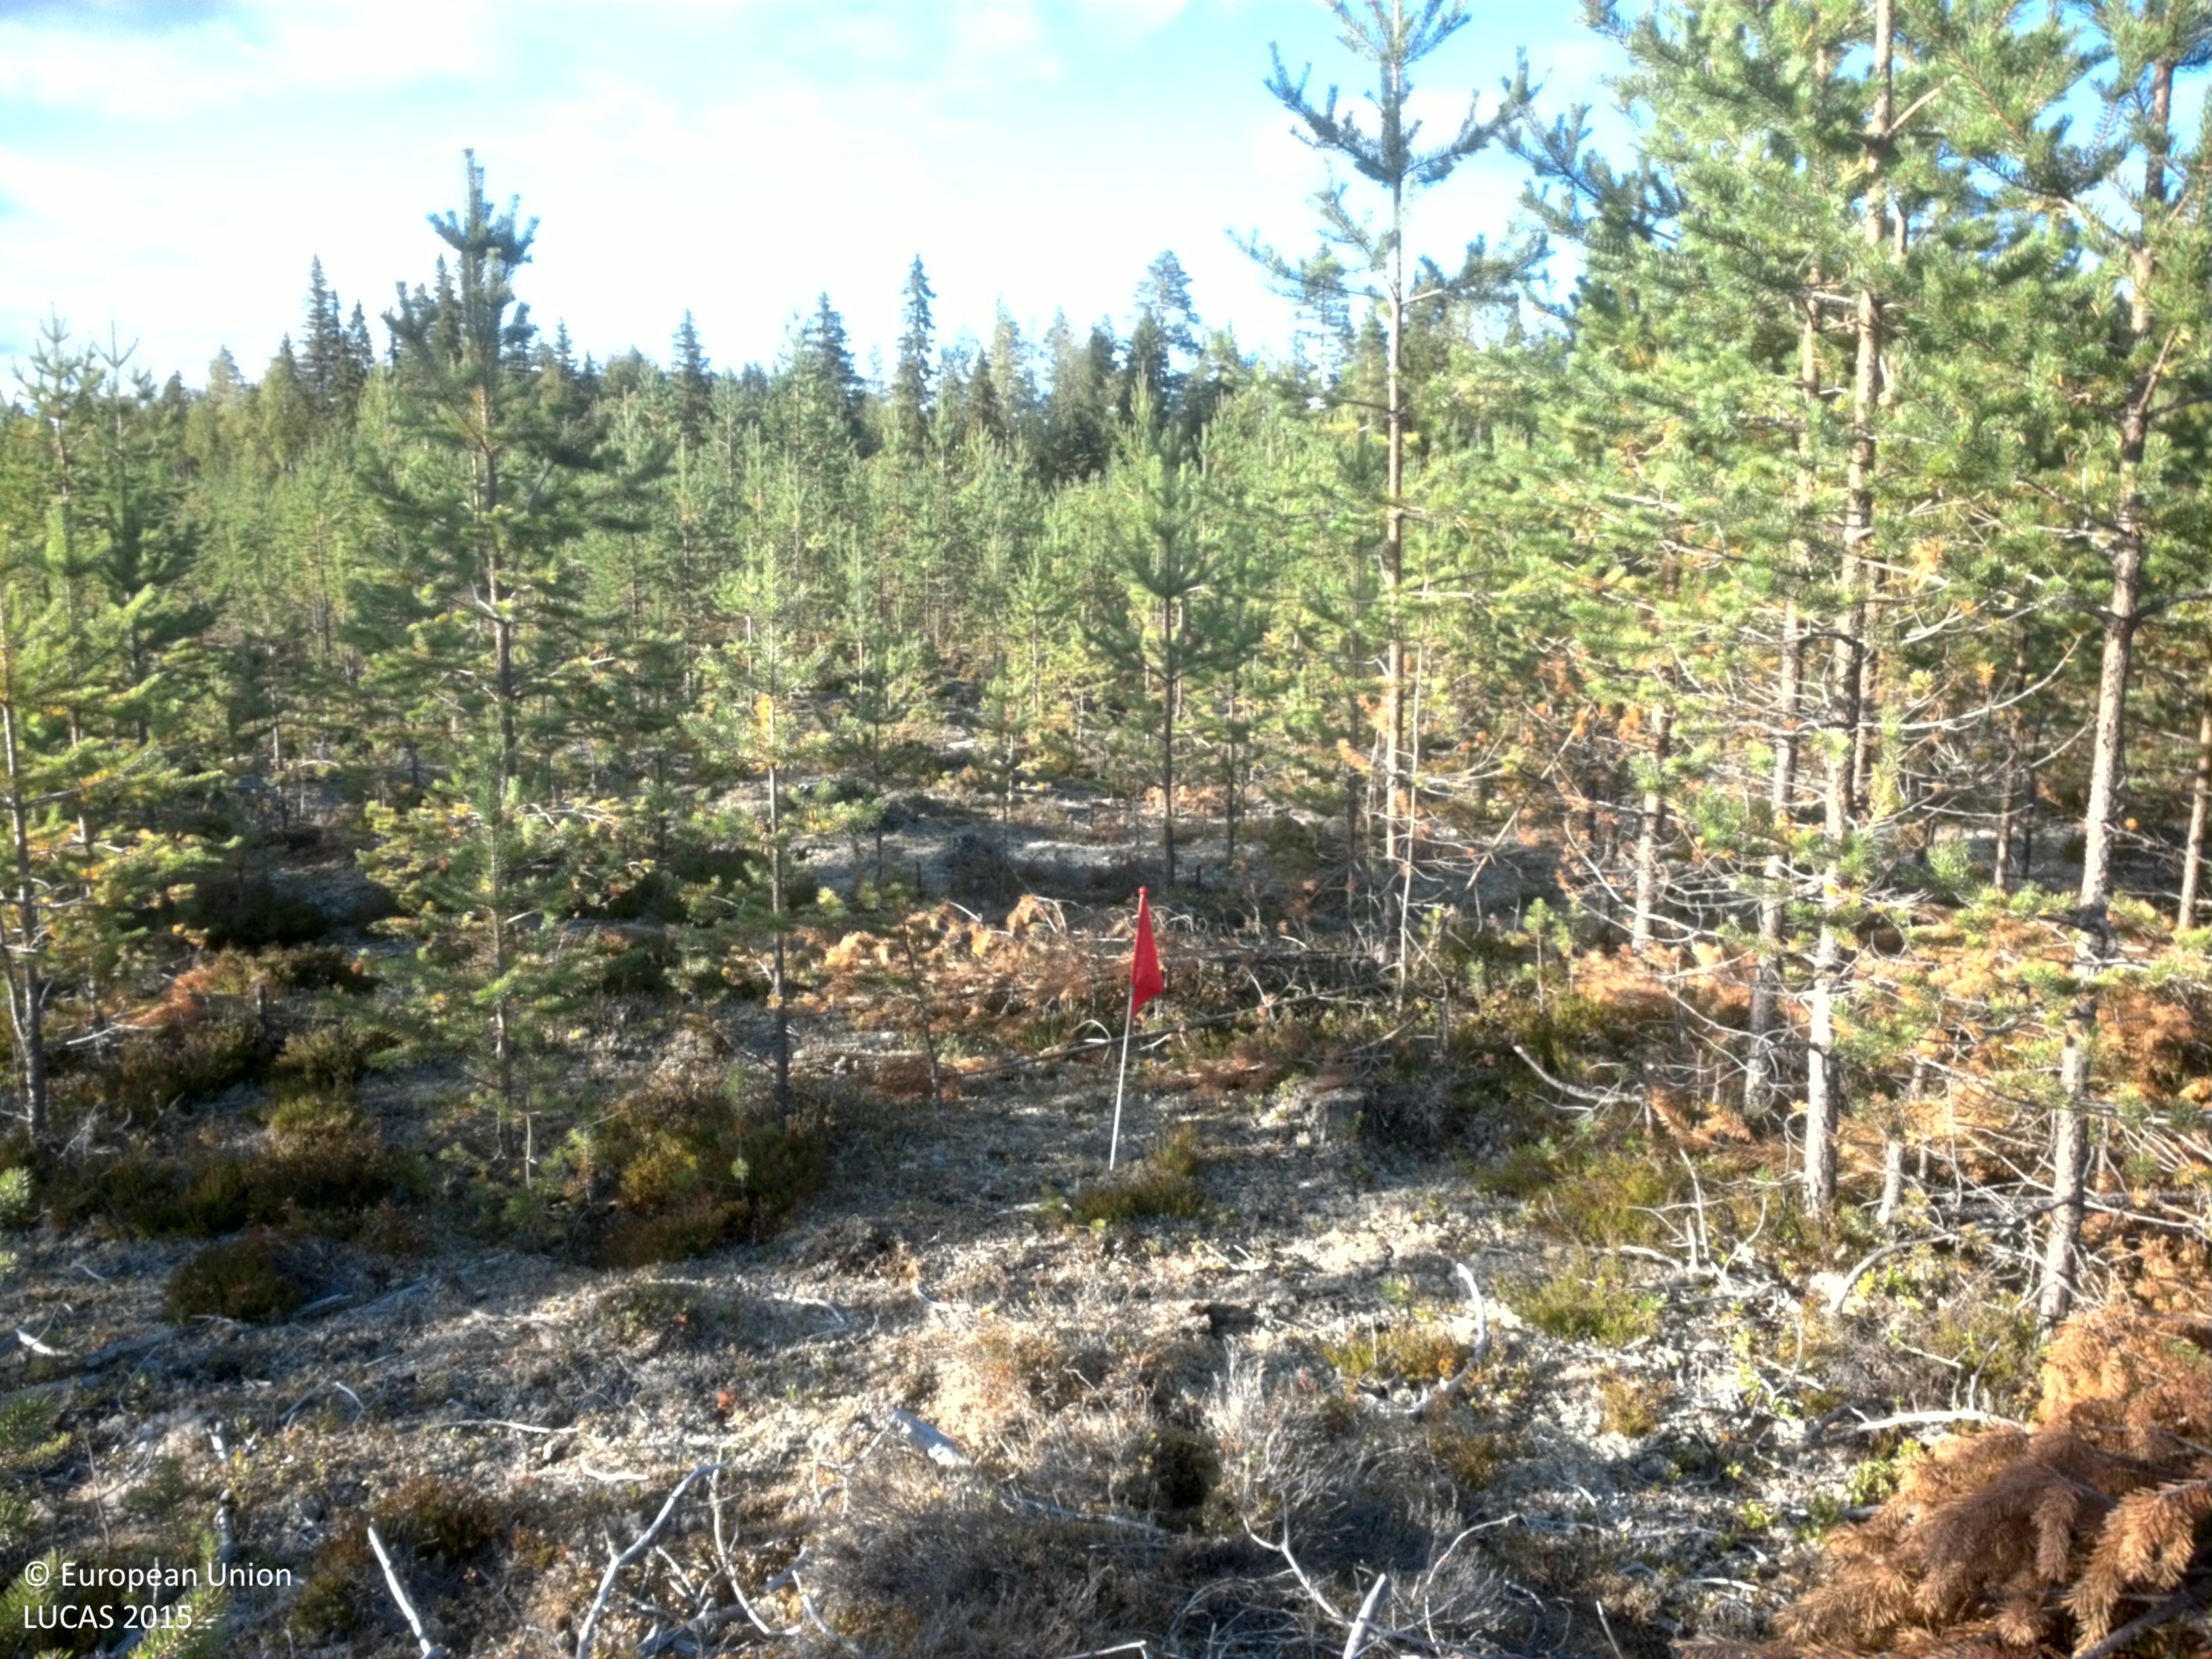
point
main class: Woodland
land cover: Pine dominated coniferous woodland
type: boreal forest
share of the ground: 50 - 75 %
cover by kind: coniferous forest trees 65 %, lichens and mosses 25 %, shrubs 10 %
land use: Forestry
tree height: < 5 m
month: September
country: SE
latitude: 64.4355
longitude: 18.9633
